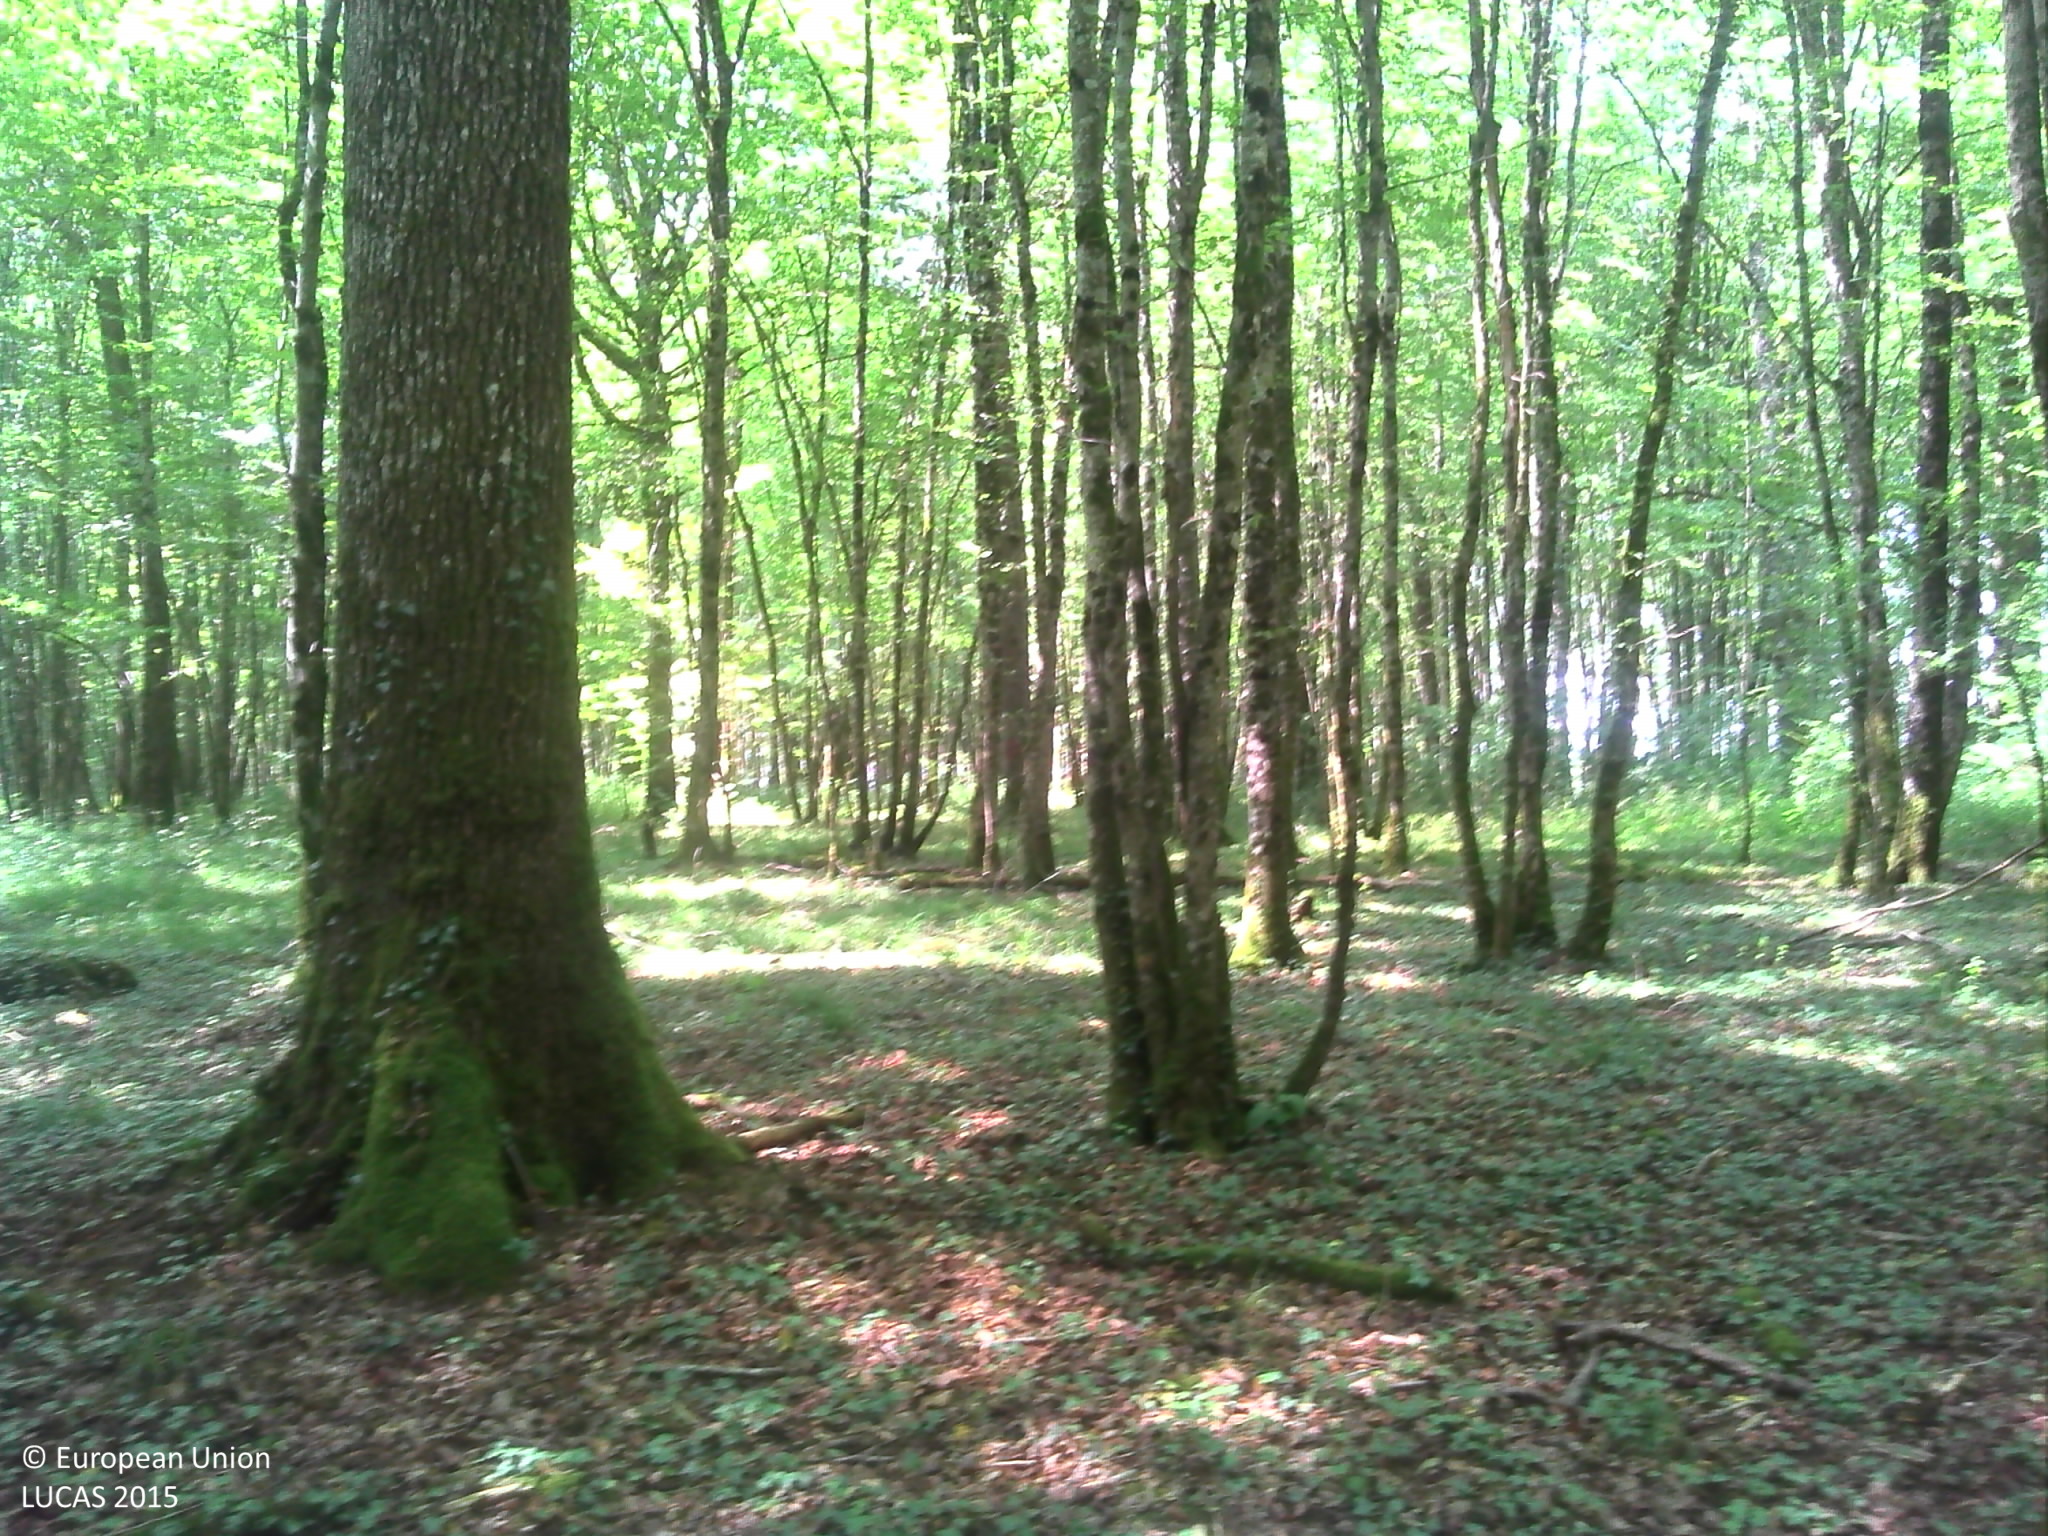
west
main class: Woodland
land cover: Broadleaved woodland
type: acidophilous oak and oak-birch forest
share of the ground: > 75 %
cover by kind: broadleaved forest trees 85 %, herbaceous plants 10 %, lichens and mosses 5 %
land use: Forestry
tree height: > 5 m
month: July
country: FR
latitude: 47.9828
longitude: 4.9748
